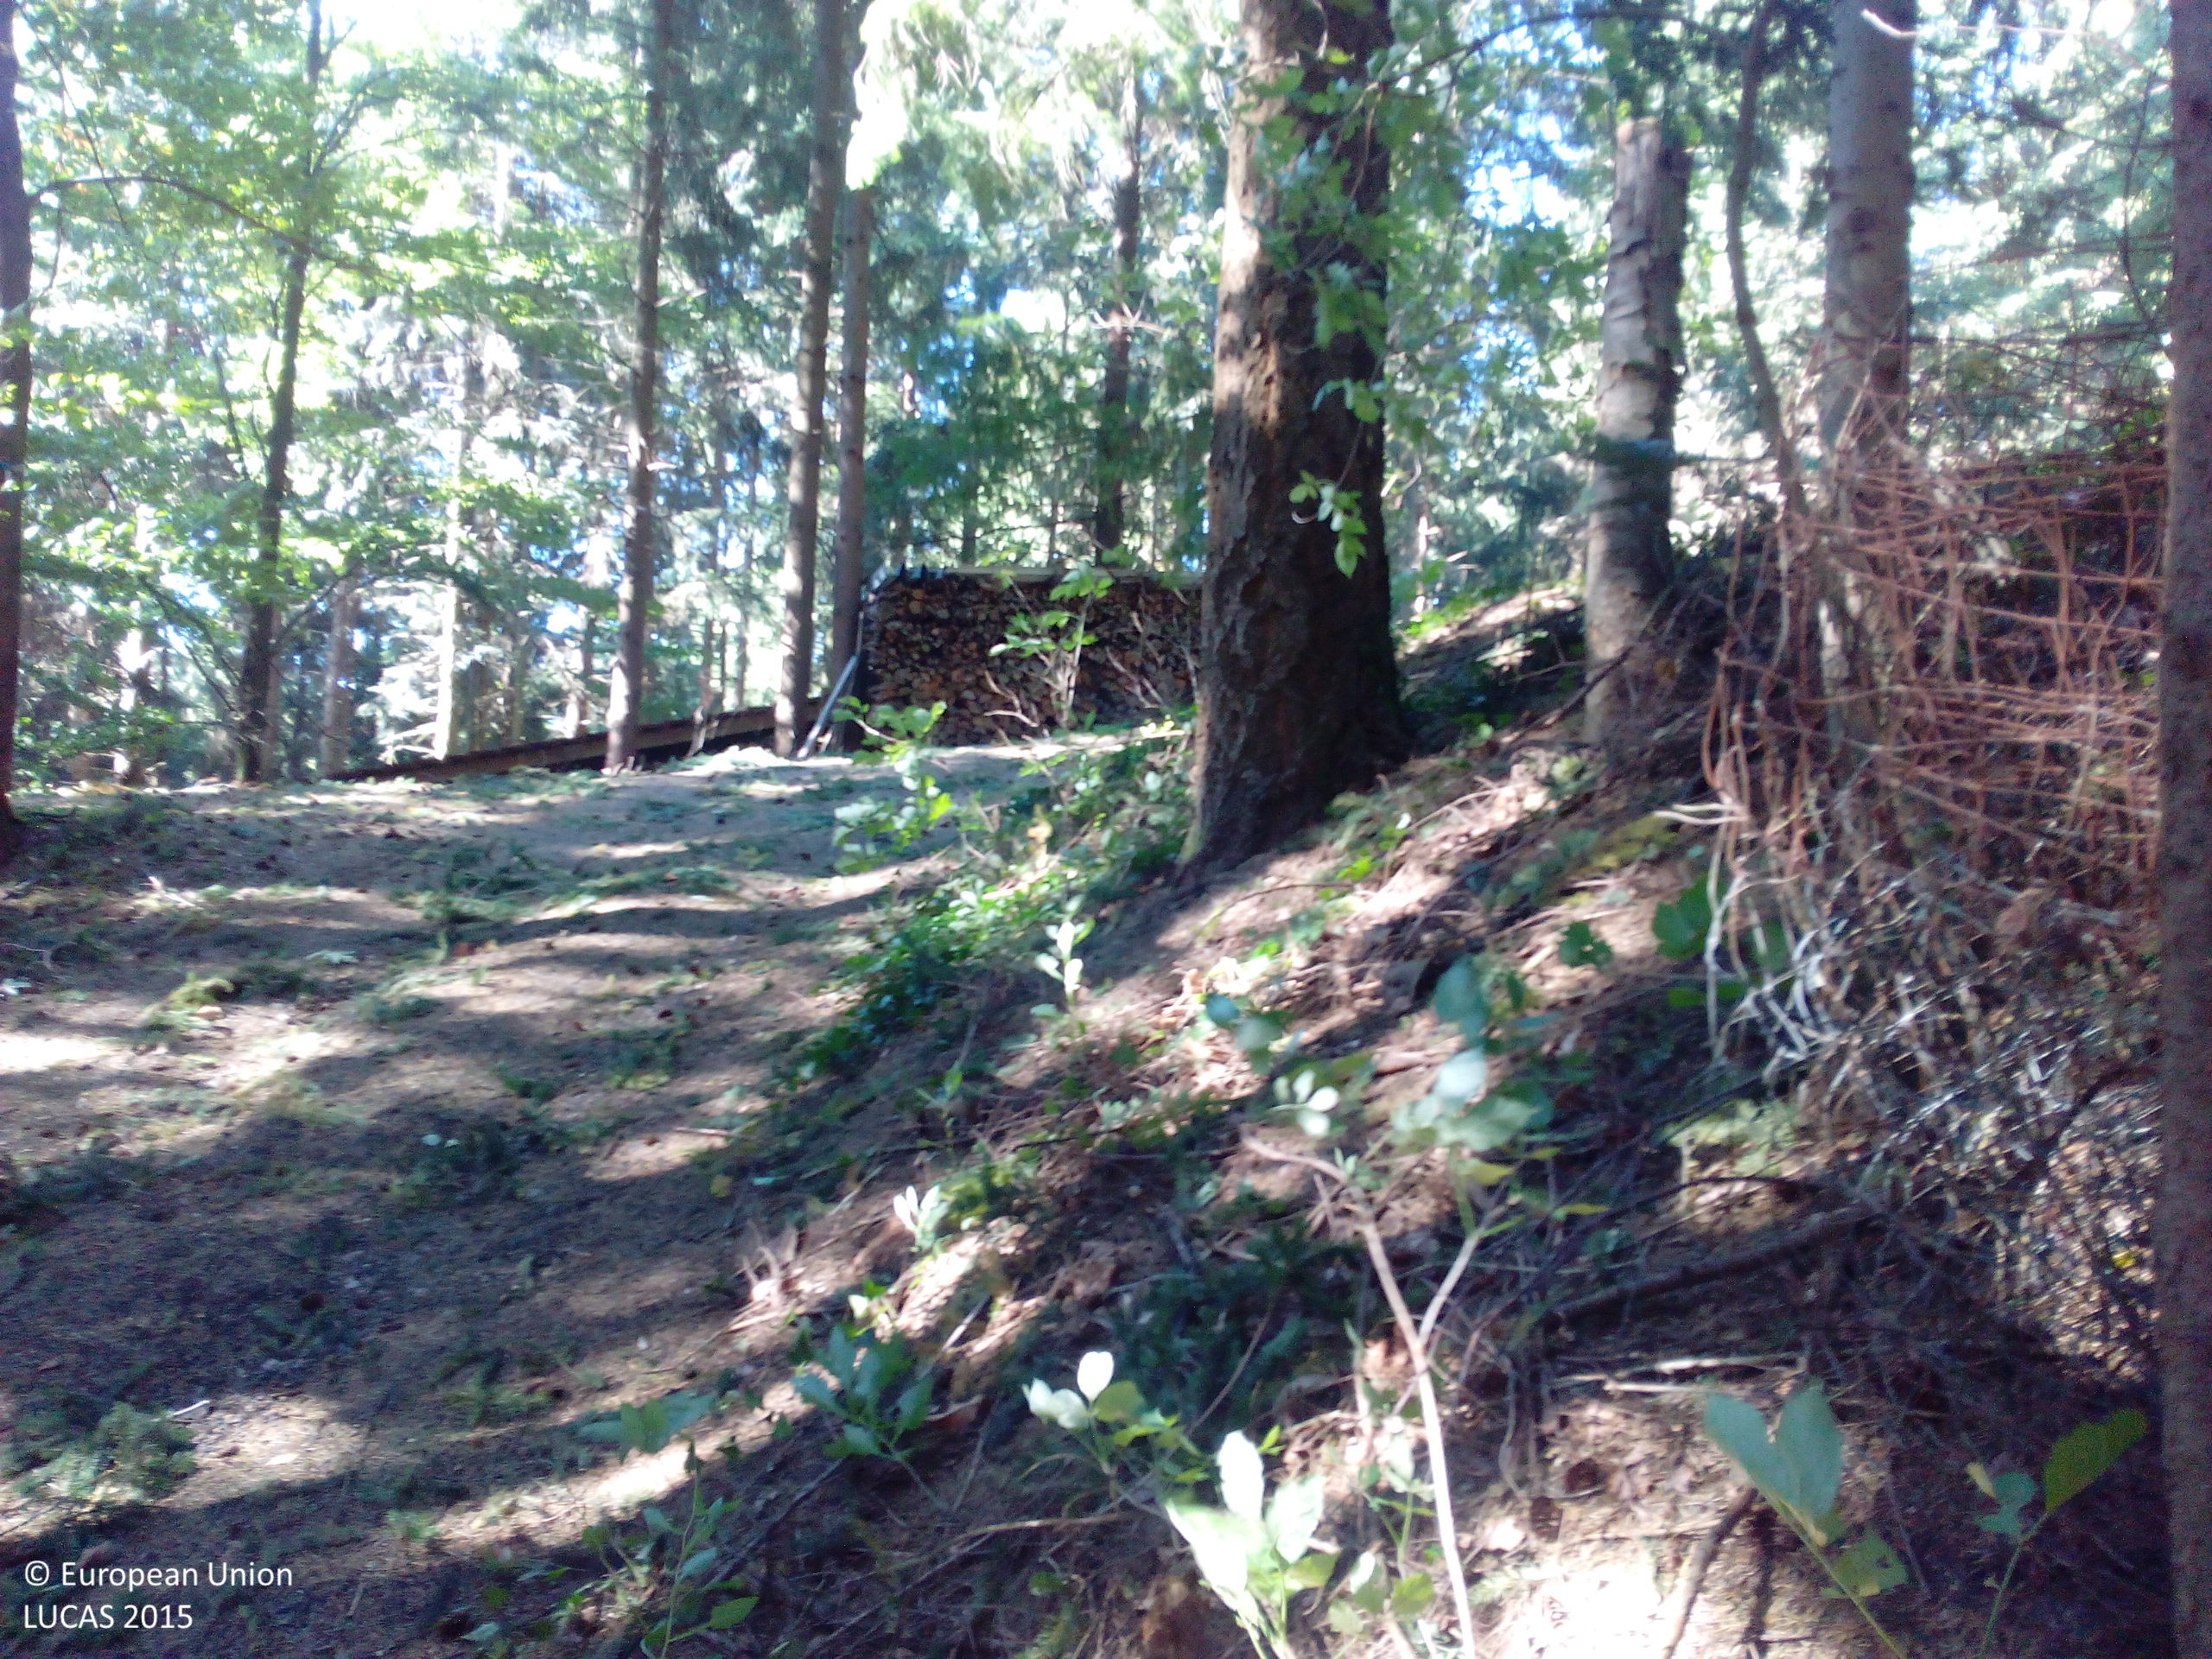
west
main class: Woodland
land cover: Spruce dominated coniferous woodland
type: hemiboreal forest and nemoral coniferous forest and mixed broadleaved-coniferous forest
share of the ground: > 75 %
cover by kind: coniferous forest trees 95 %, shrubs 5 %
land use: Forestry
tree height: > 5 m
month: September
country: DE
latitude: 48.5504
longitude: 8.1719
